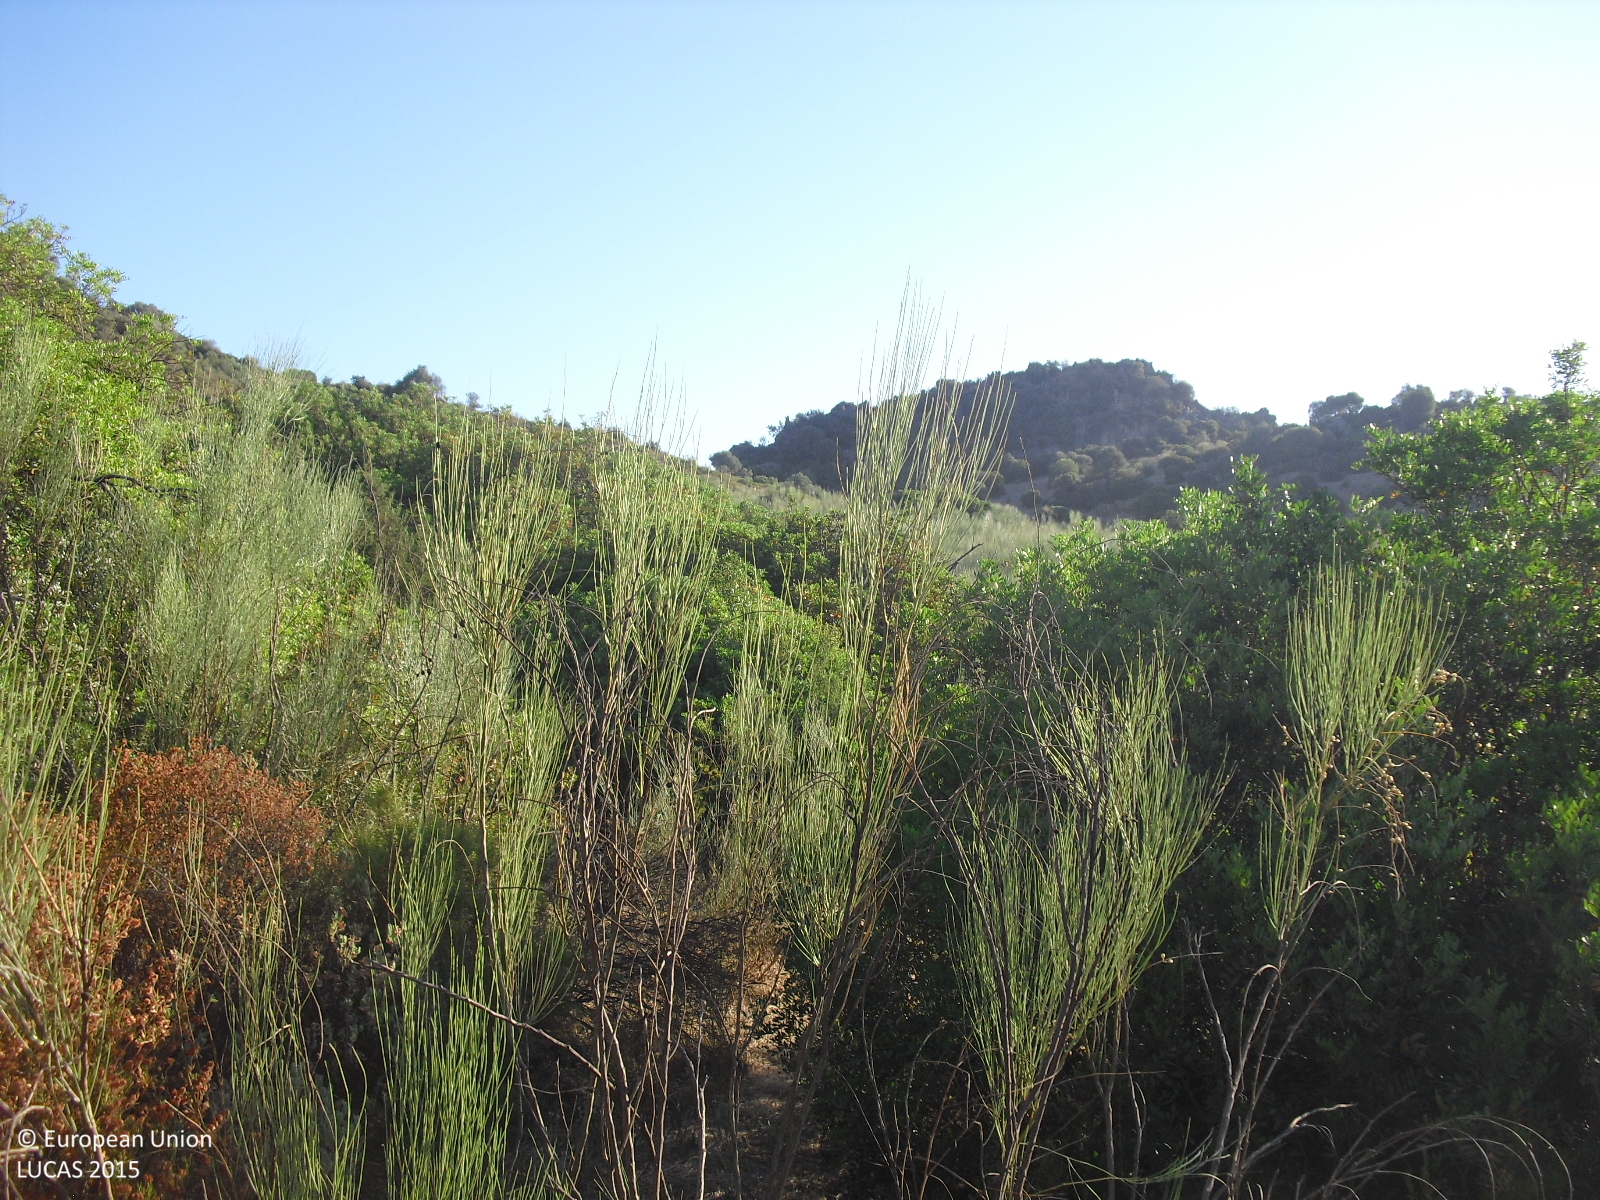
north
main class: Shrubland
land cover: Shrubland with sparse tree cover
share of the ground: 50 - 75 %
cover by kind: shrubs 50 %, herbaceous plants 45 %, broadleaved forest trees 5 %
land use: Agriculture (excluding fallow land and kitchen gardens)
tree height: < 5 m
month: July
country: ES
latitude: 36.9881
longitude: -5.3651
